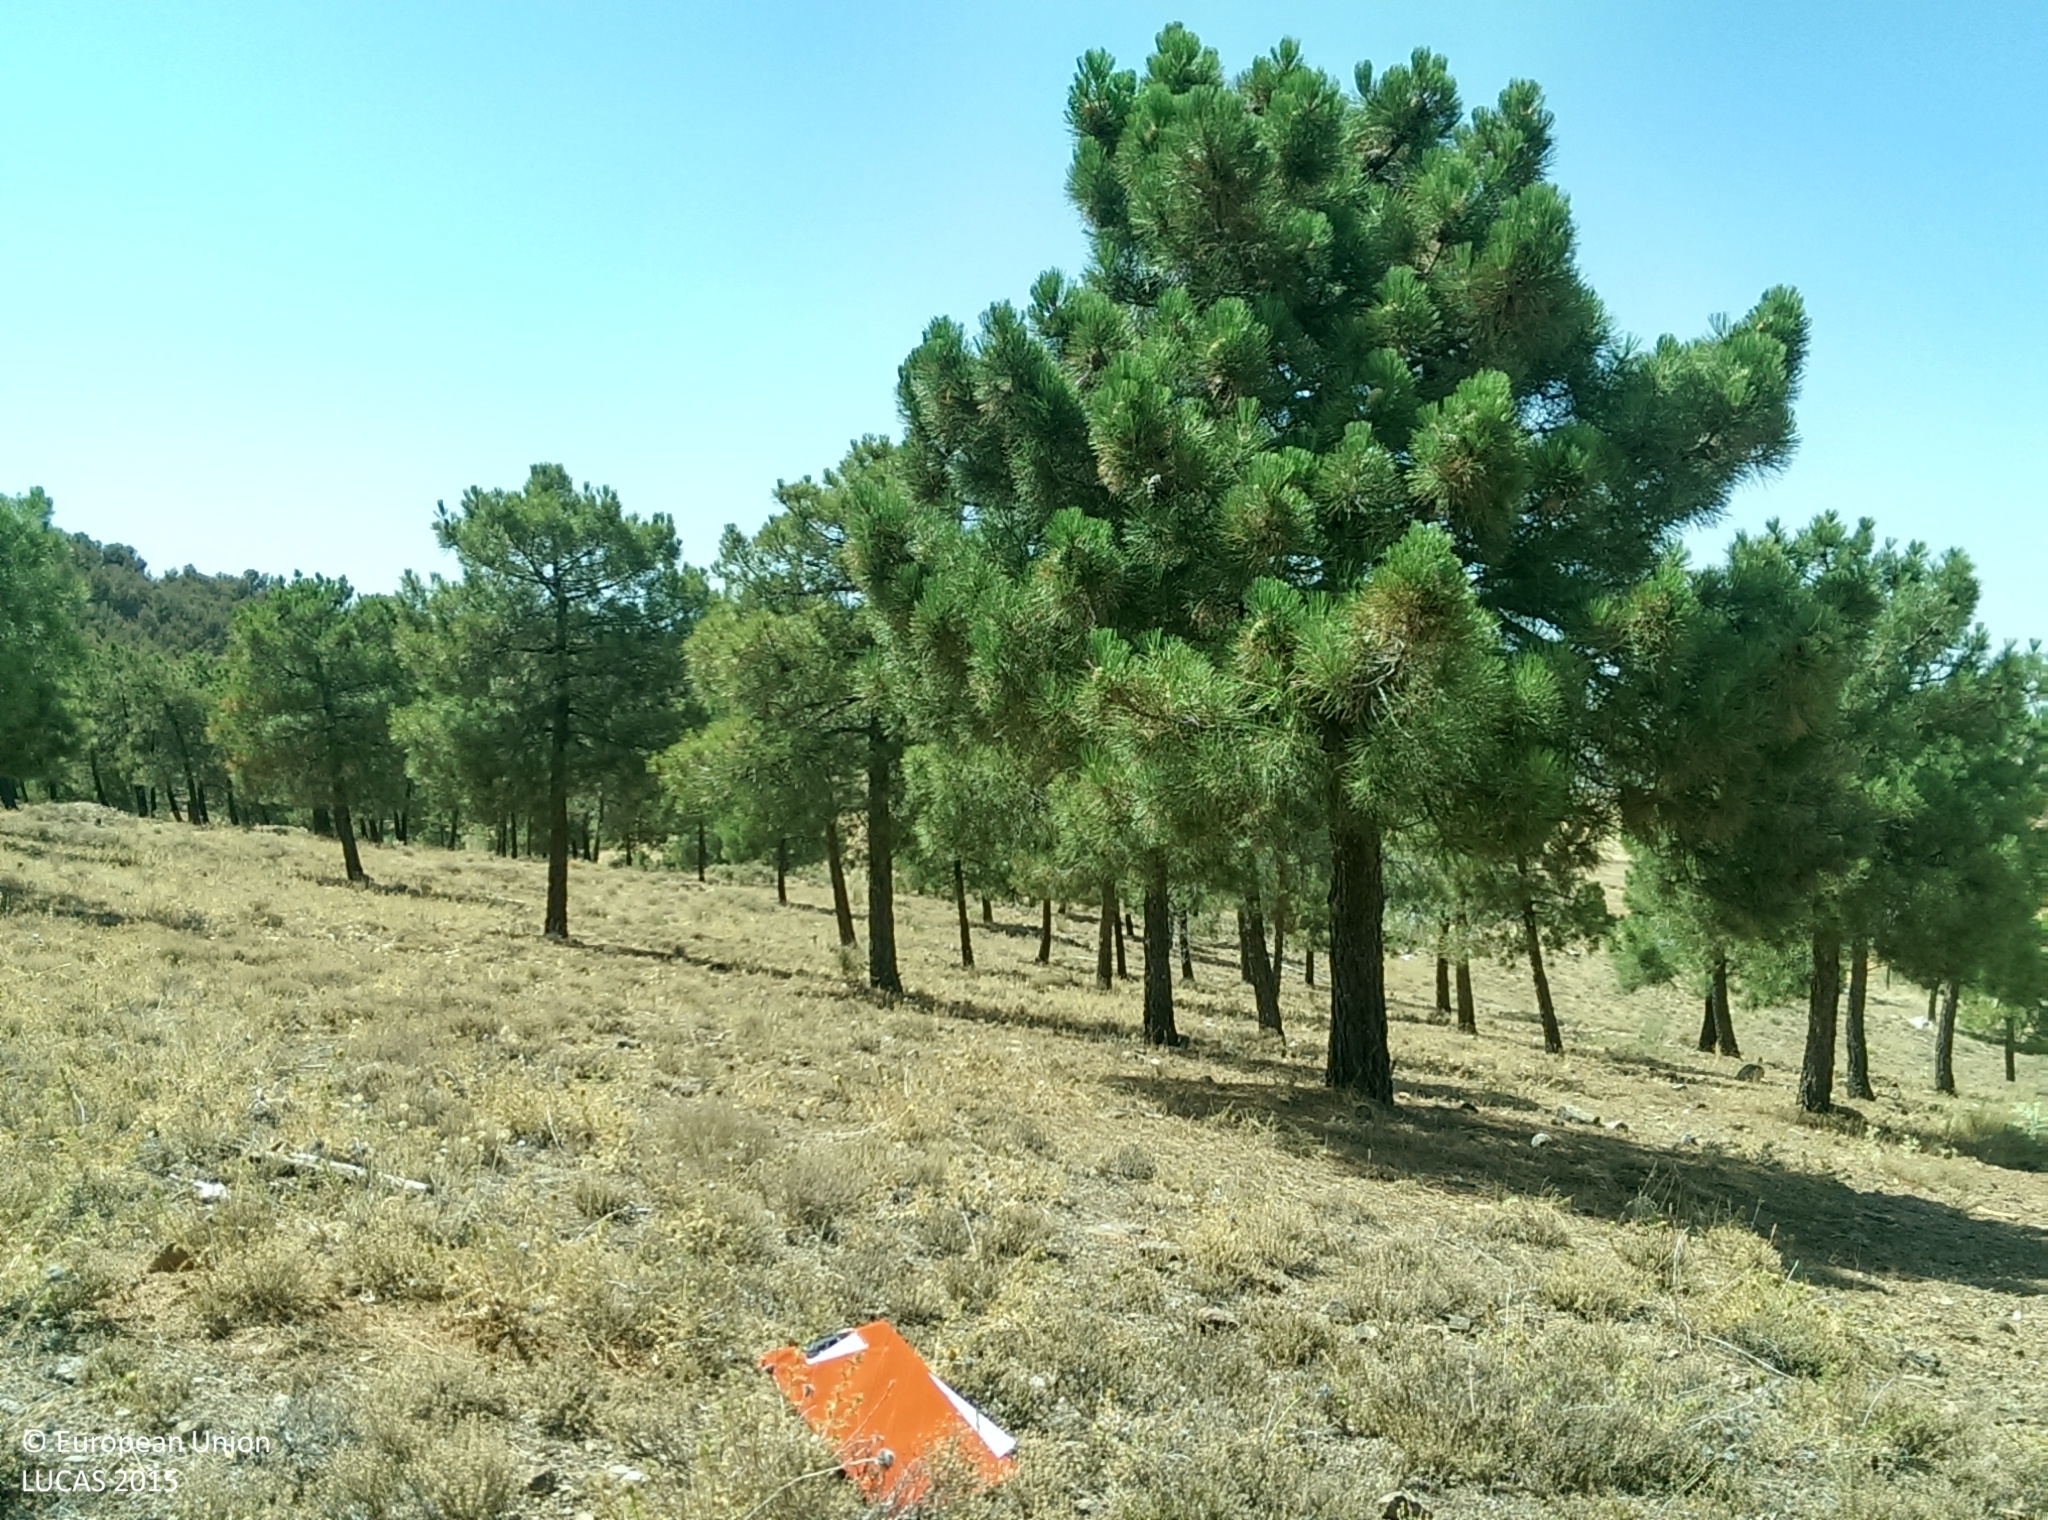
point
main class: Woodland
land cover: Pine dominated coniferous woodland
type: coniferous forest of the mediterranean region
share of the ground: 10 - 25 %
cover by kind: herbaceous plants 40 %, coniferous forest trees 20 %, shrubs 20 %, unconsolidated bare surface 20 %
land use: Forestry
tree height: > 5 m
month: July
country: ES
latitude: 37.2289
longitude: -3.1846
